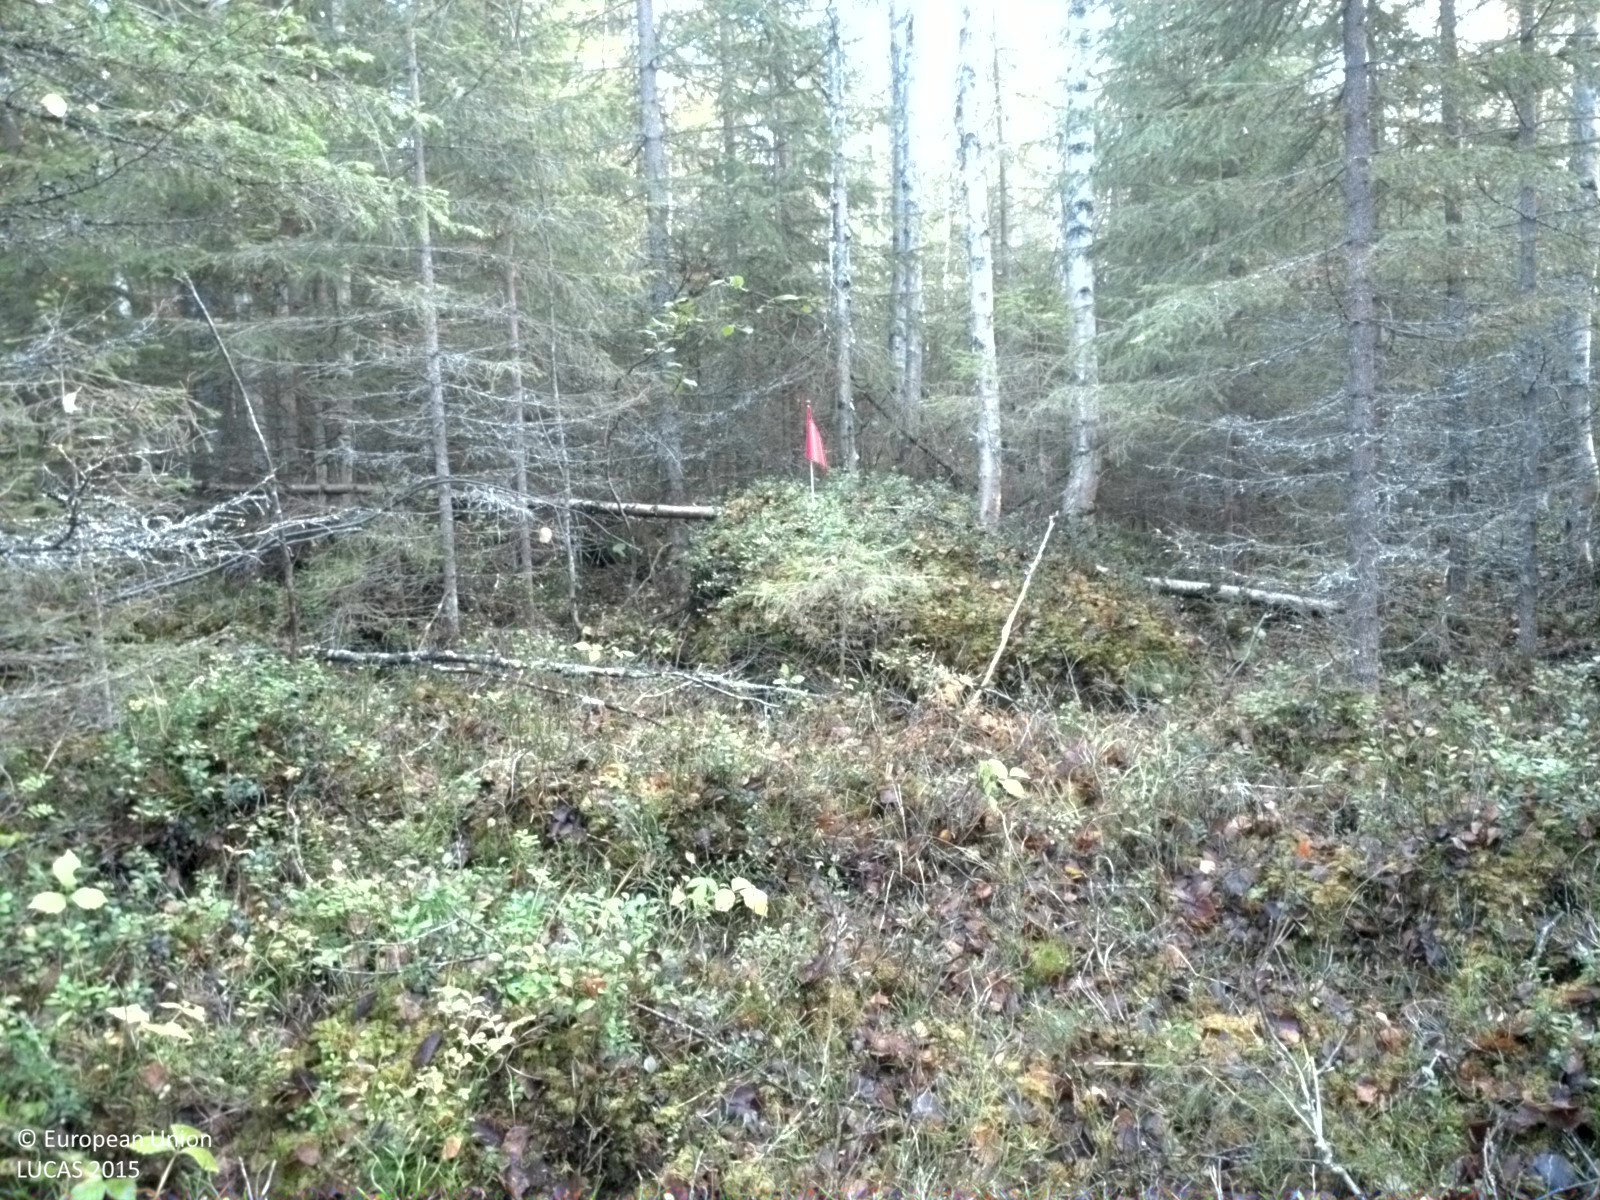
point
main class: Woodland
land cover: Spruce dominated mixed woodland
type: boreal forest
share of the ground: 50 - 75 %
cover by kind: coniferous forest trees 40 %, shrubs 35 %, broadleaved forest trees 25 %
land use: Forestry
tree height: > 5 m
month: October
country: SE
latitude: 65.9974
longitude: 22.2023
